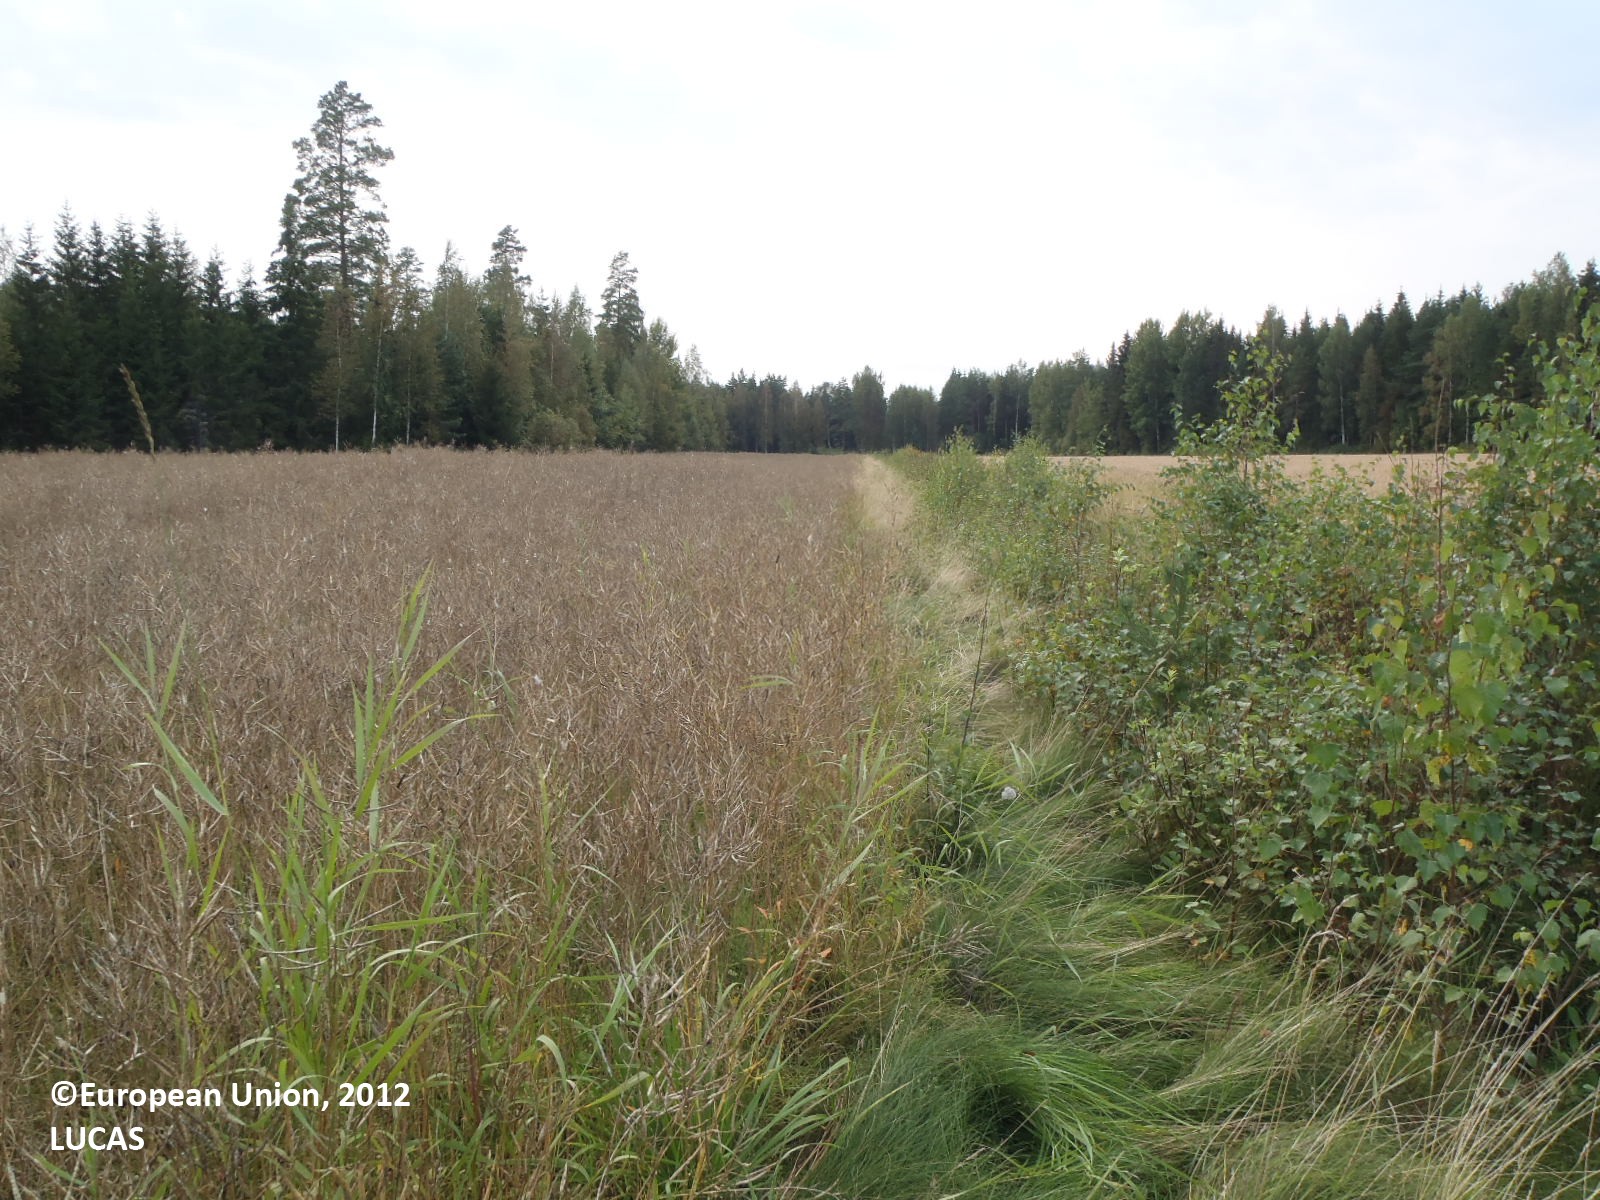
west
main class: Cropland
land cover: Rape and turnip rape
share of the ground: > 75 %
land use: Agriculture (excluding fallow land and kitchen gardens)
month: August
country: FI
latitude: 60.9318
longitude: 22.5598
